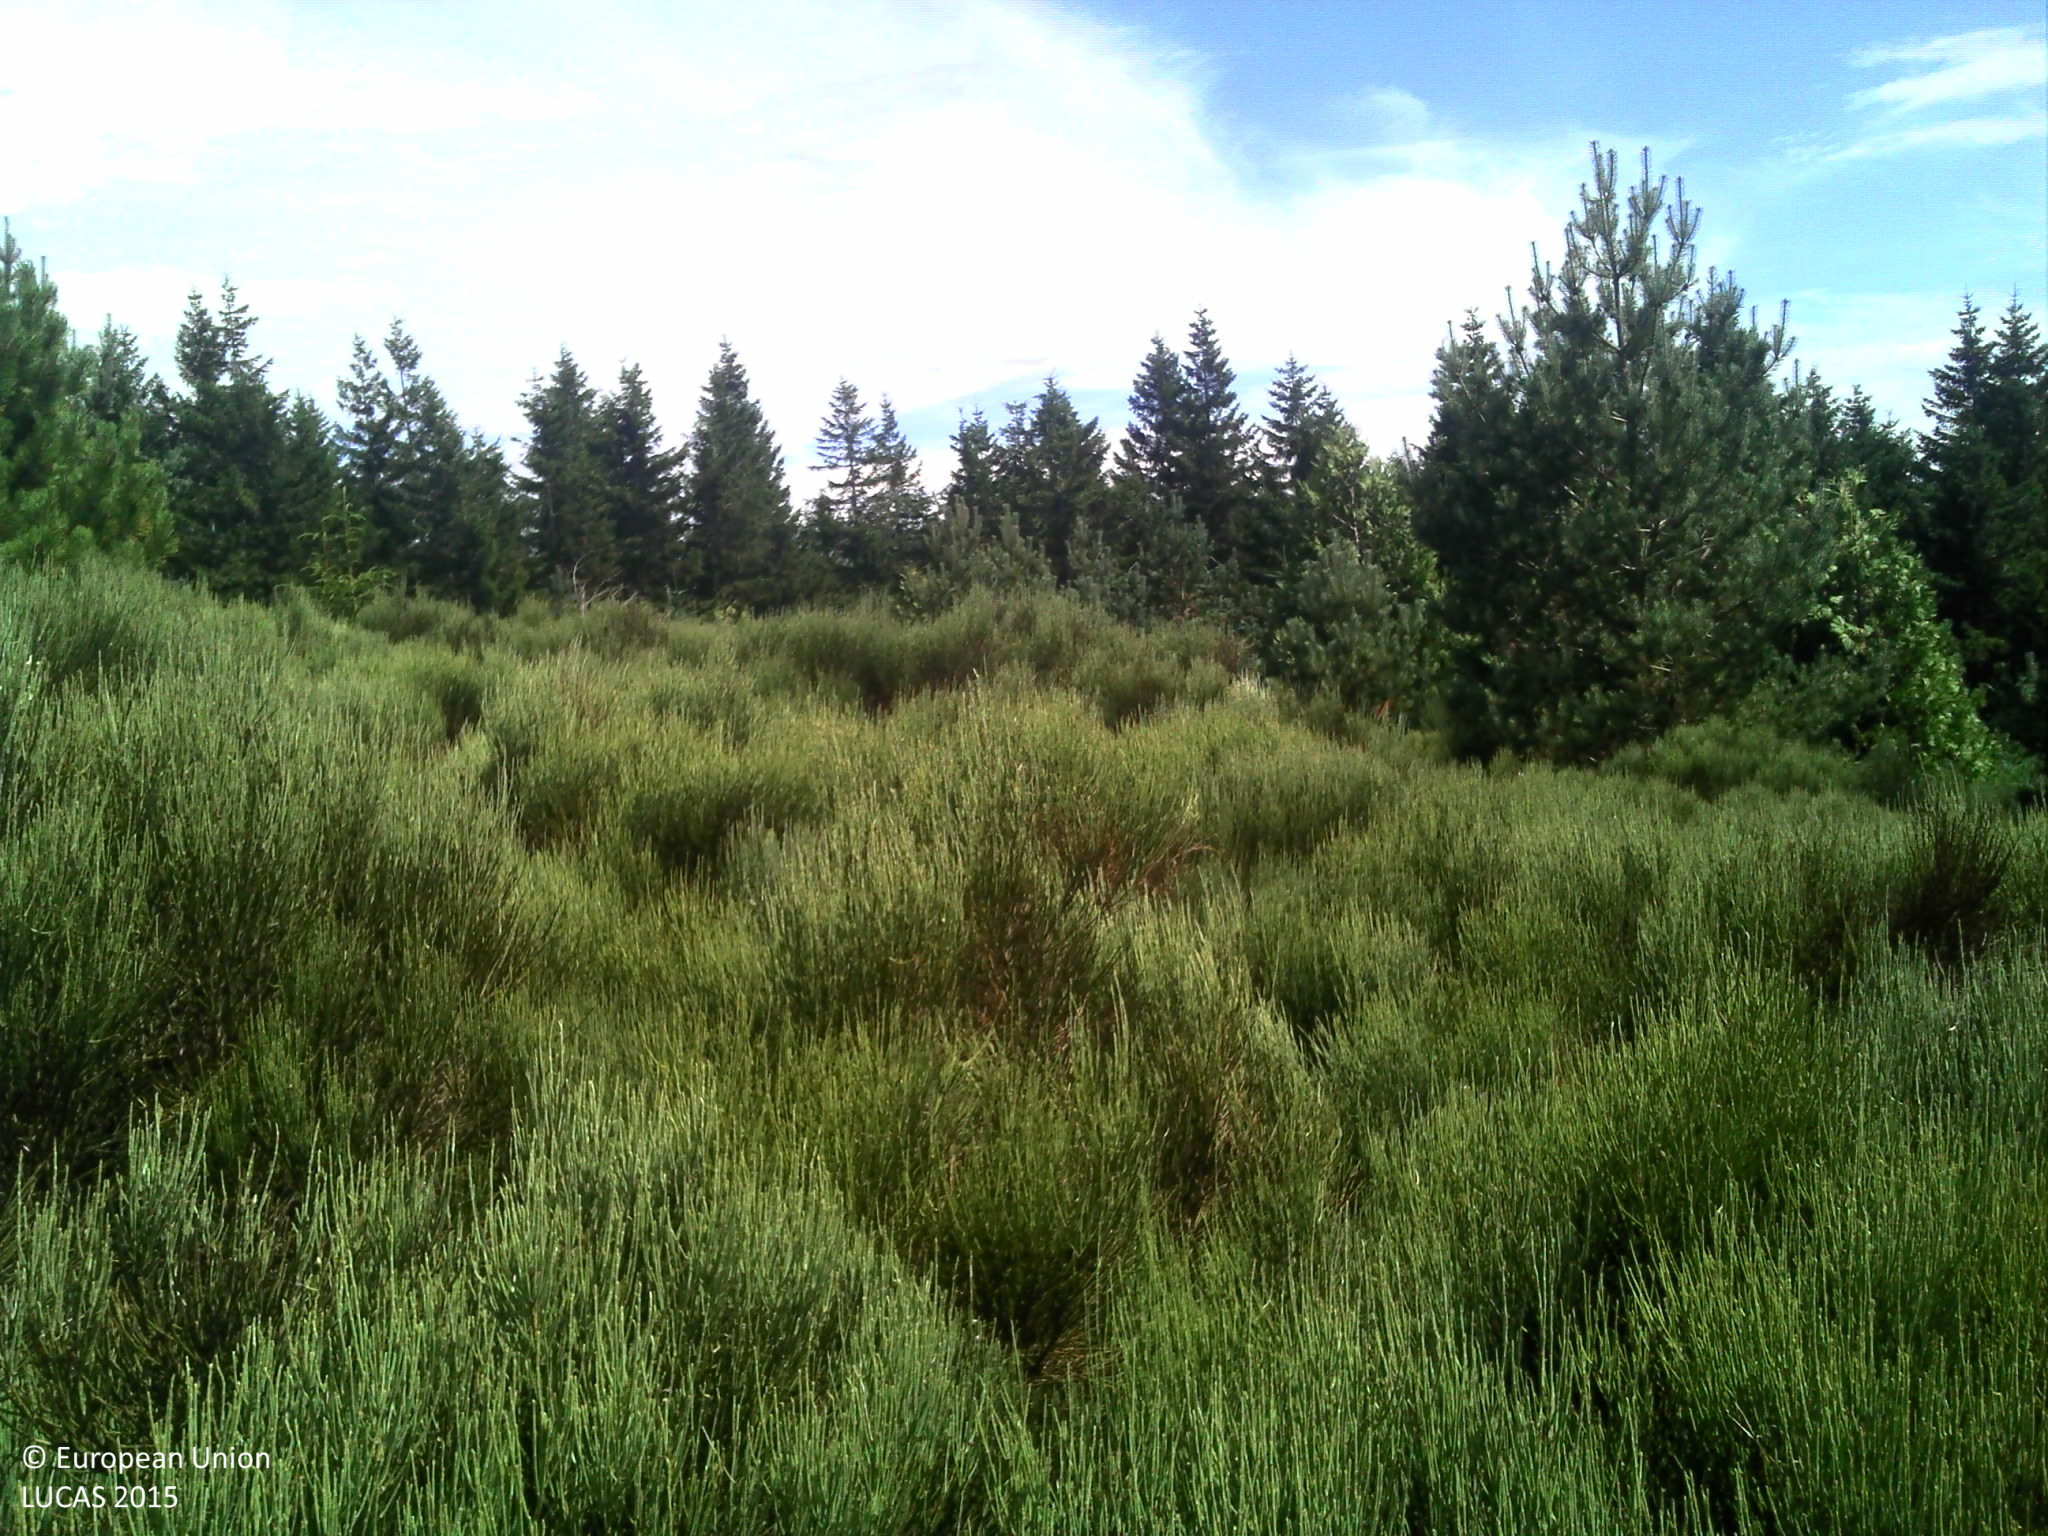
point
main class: Shrubland
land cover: Shrubland with sparse tree cover
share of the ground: > 75 %
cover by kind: shrubs 95 %, coniferous forest trees 5 %
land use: Semi-natural and natural areas not in use
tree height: < 5 m
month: July
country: FR
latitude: 44.6062
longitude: 3.9199
